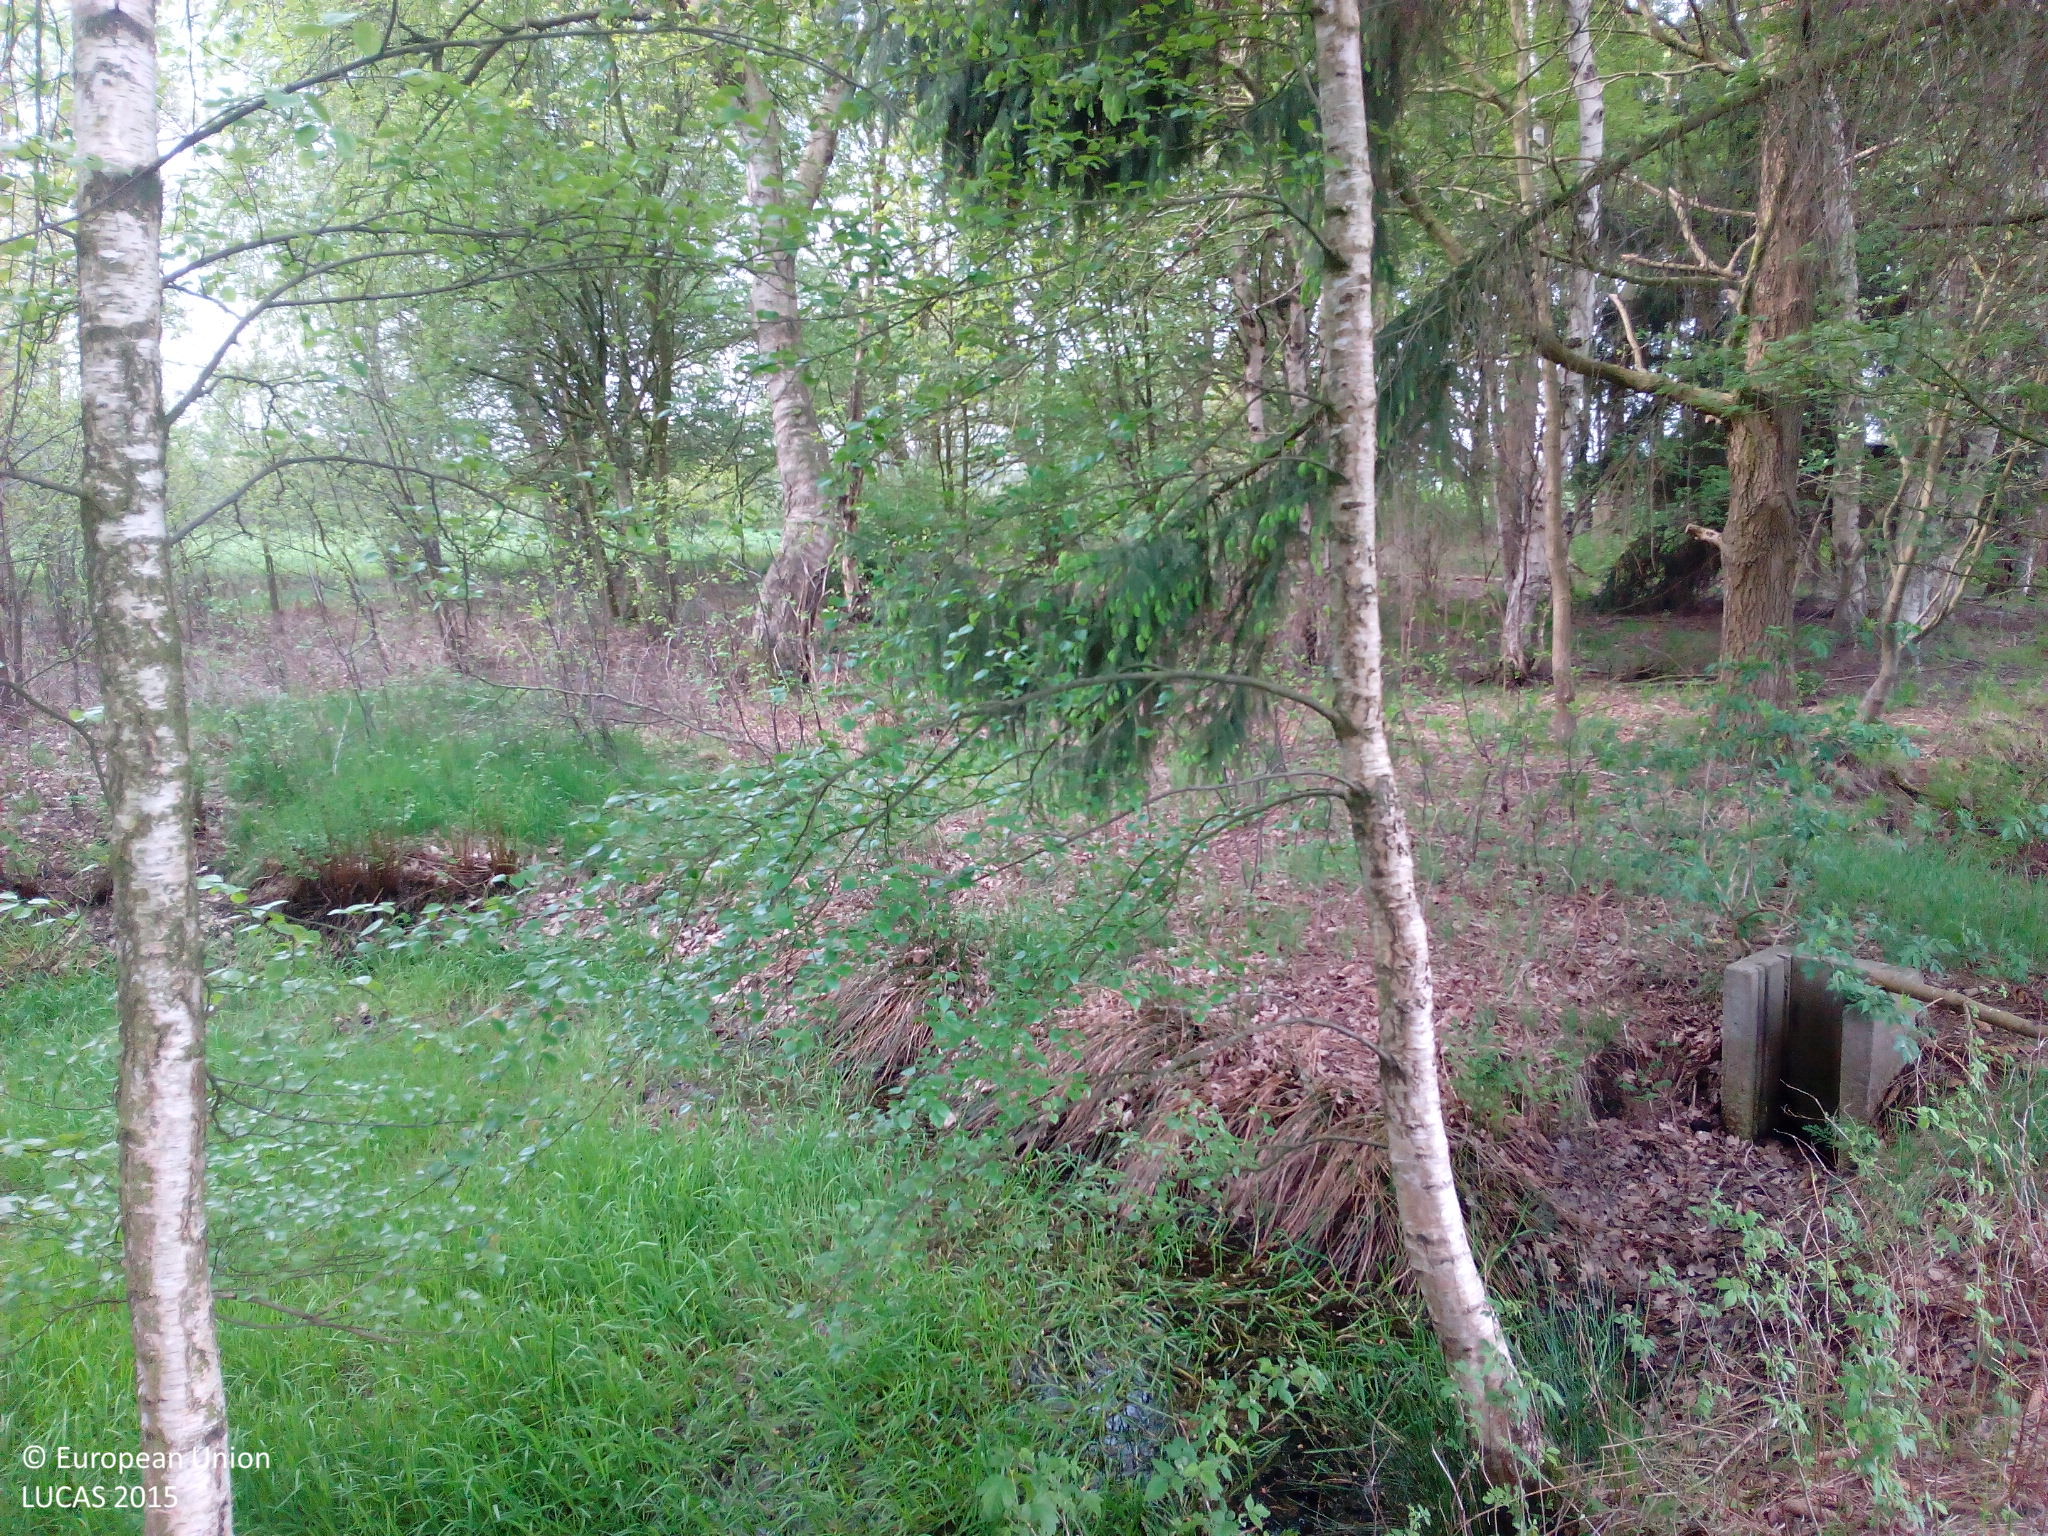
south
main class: Woodland
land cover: Broadleaved woodland
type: mire and swamp forests
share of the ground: > 75 %
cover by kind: broadleaved forest trees 70 %, coniferous forest trees 10 %, shrubs 10 %, herbaceous plants 10 %
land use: Semi-natural and natural areas not in use
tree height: > 5 m
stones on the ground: < 10 %
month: May
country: DE
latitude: 53.2376
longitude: 9.2063
